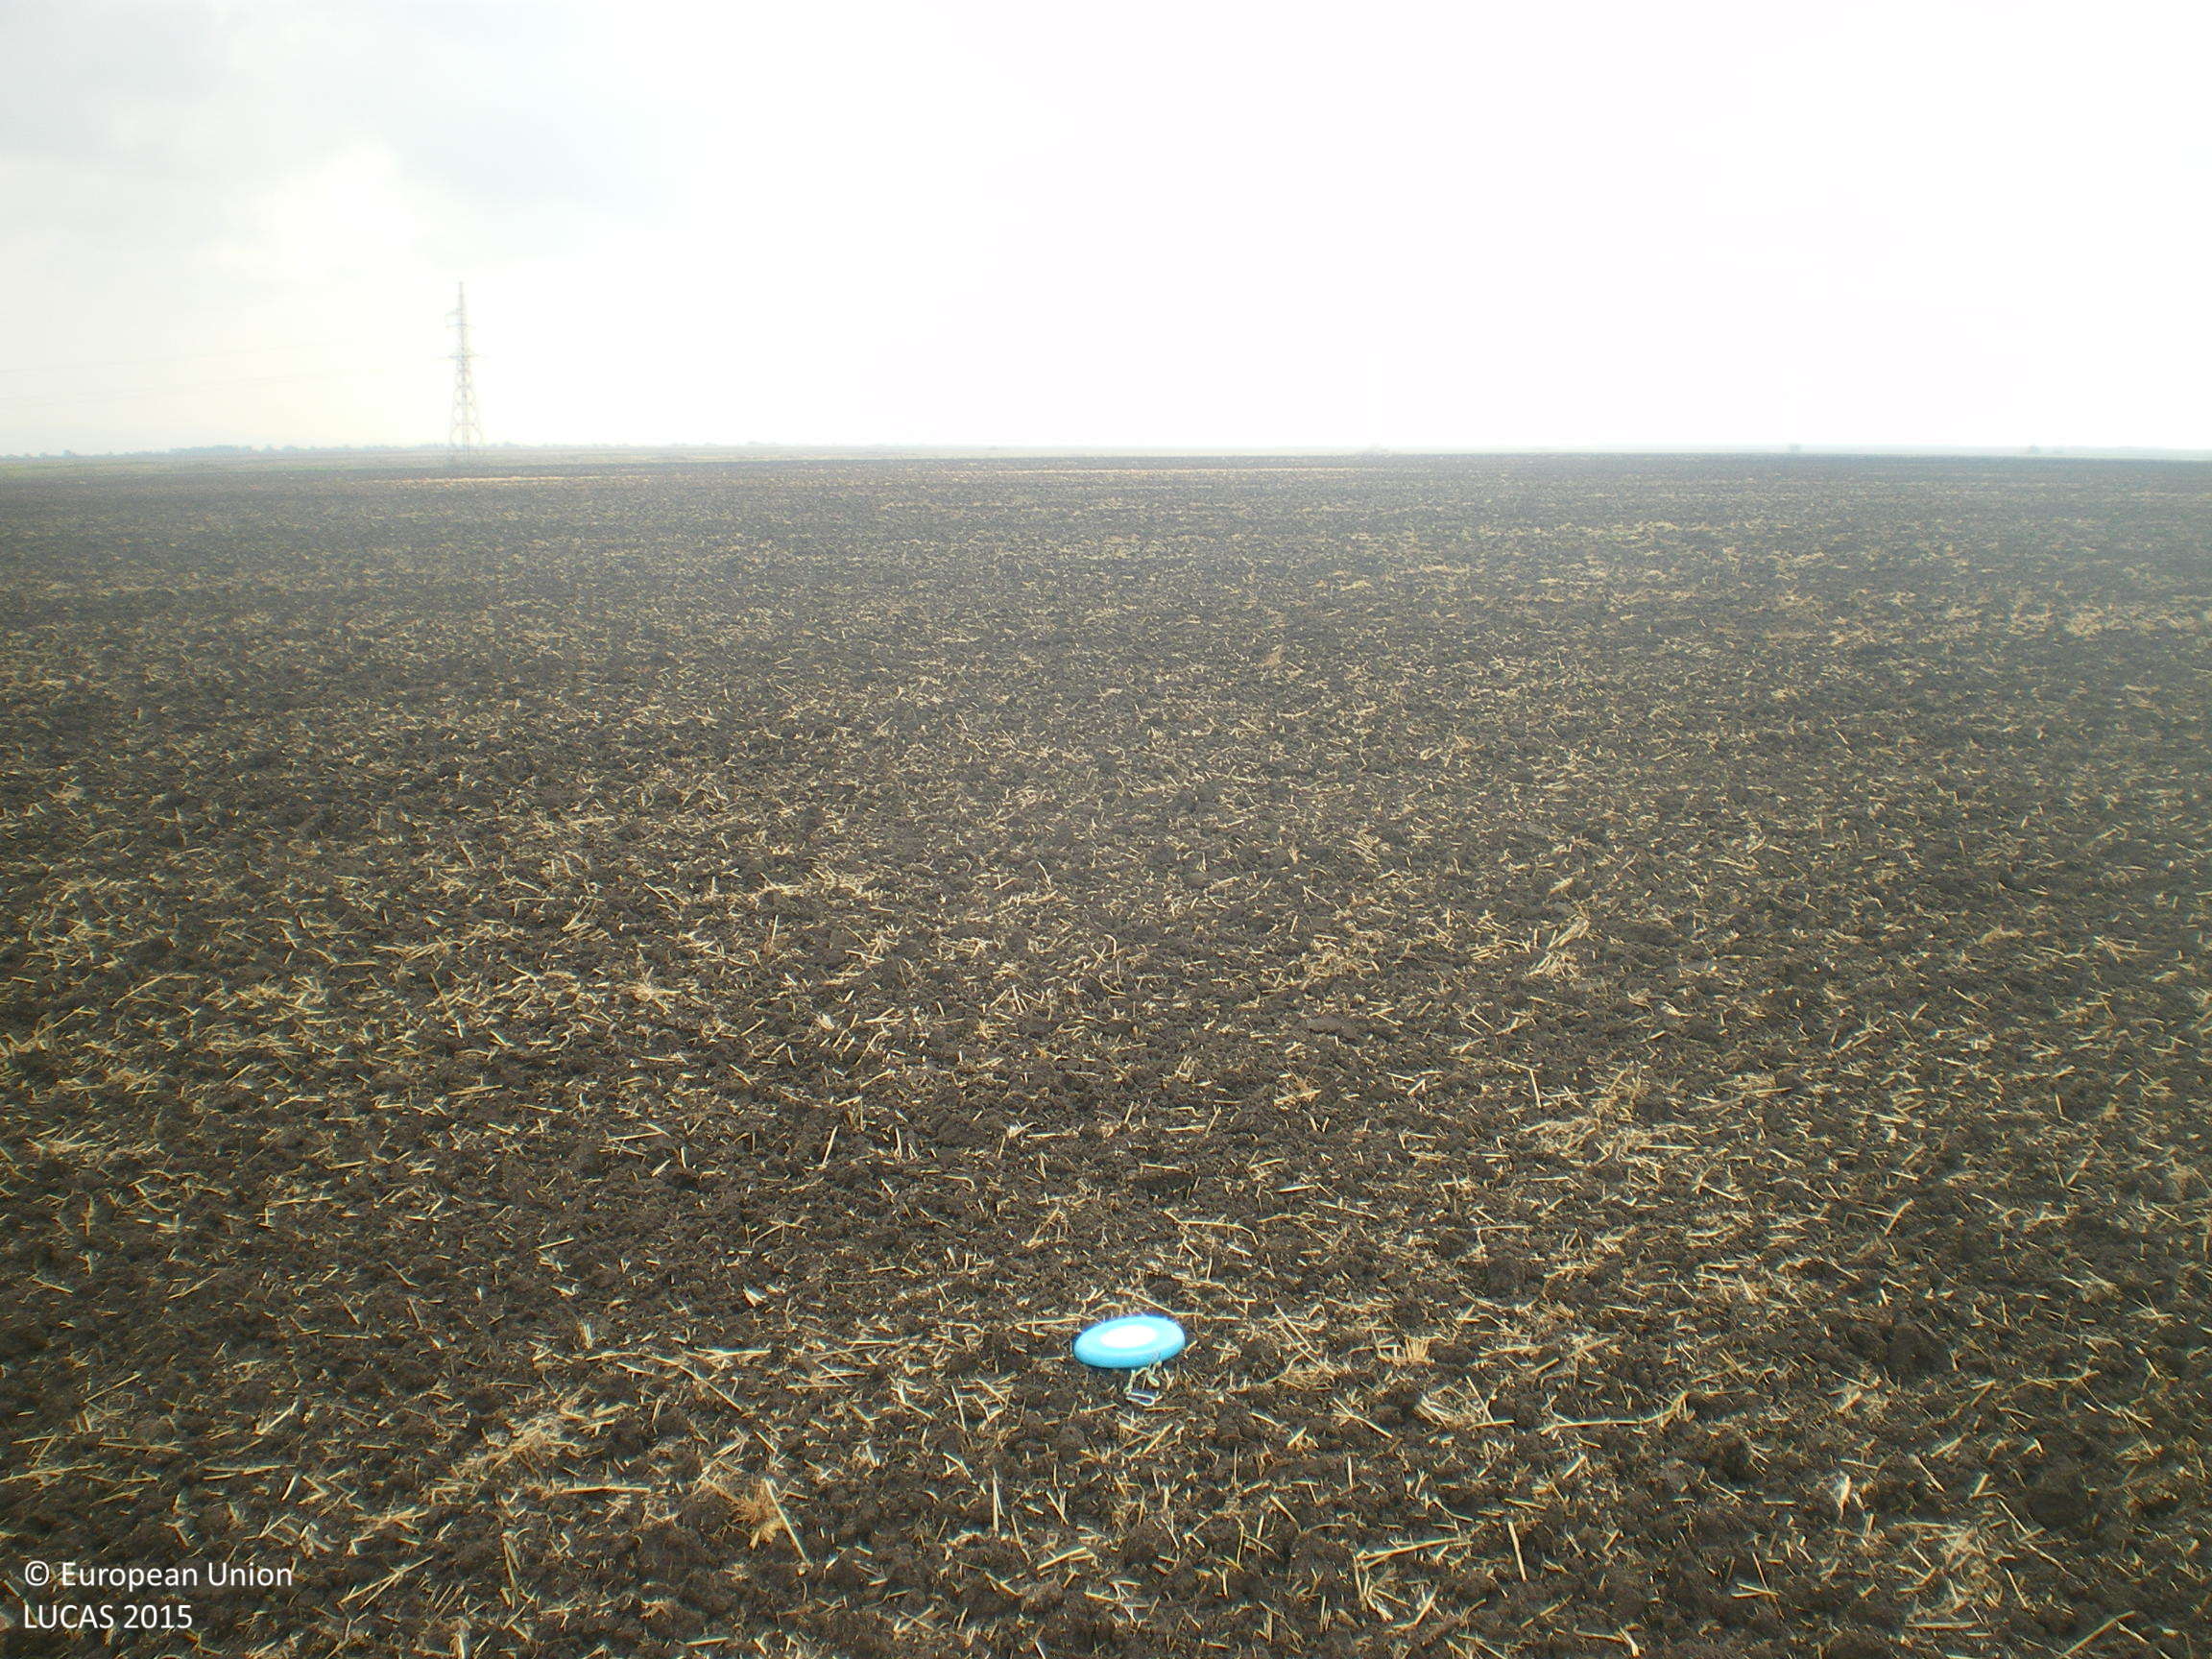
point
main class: Cropland
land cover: Common wheat
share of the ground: < 10 %
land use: Agriculture (excluding fallow land and kitchen gardens)
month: August
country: BG
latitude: 42.3626
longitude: 25.8979
